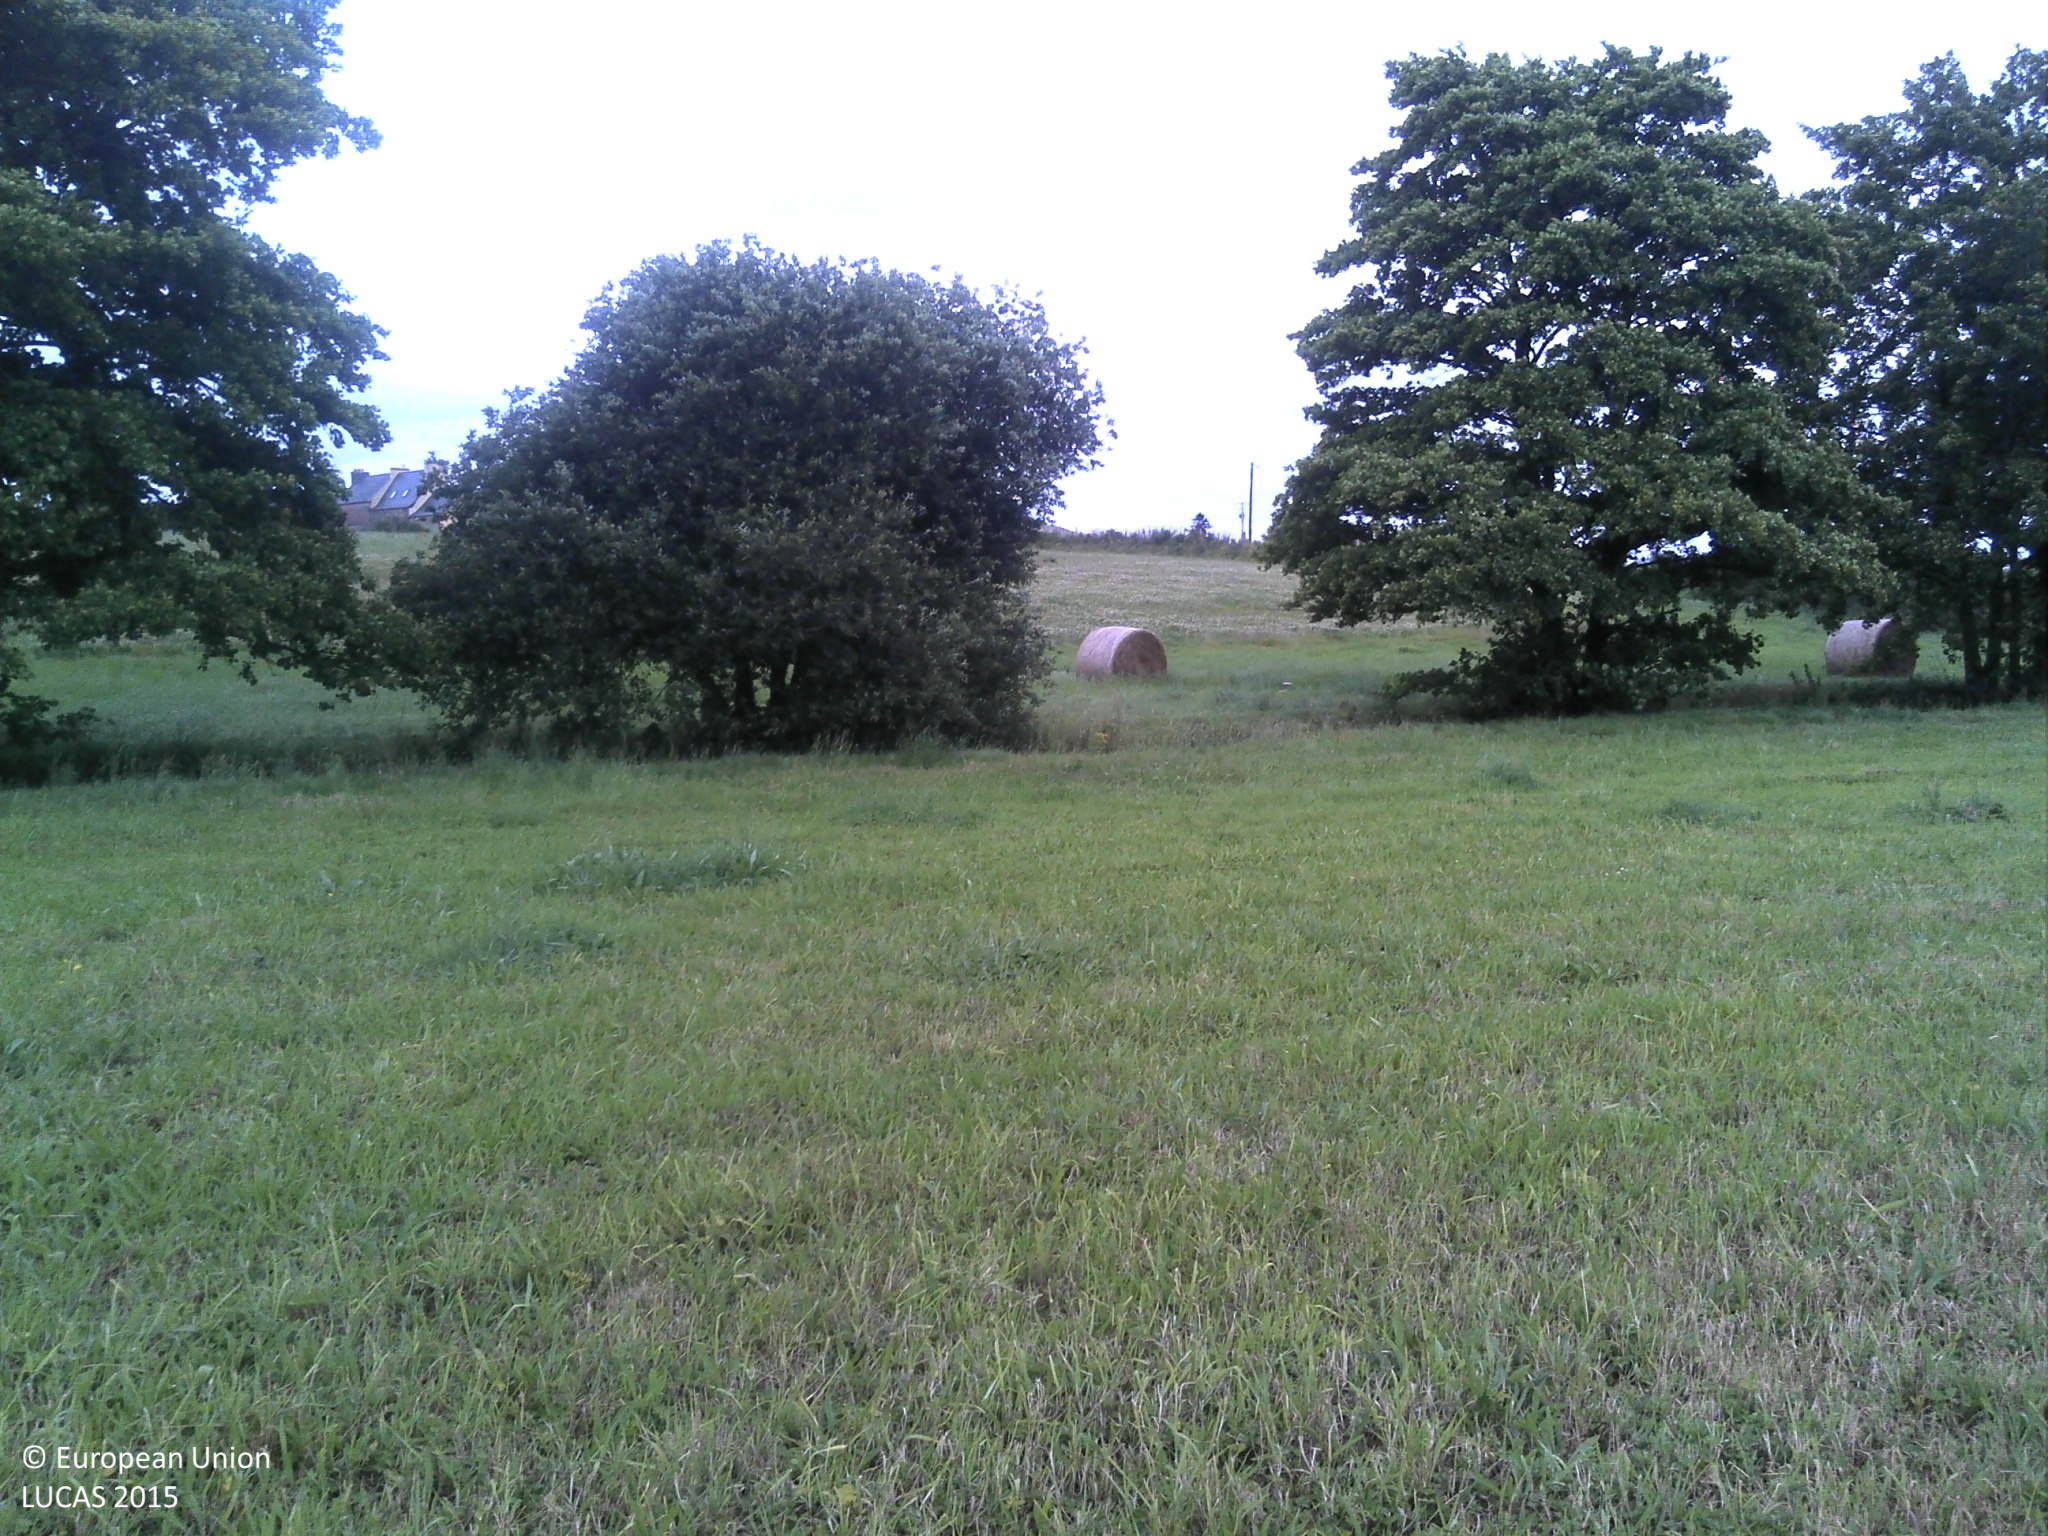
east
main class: Grassland
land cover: Grassland without tree/shrub cover
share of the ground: > 75 %
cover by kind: herbaceous plants 100 %
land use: Agriculture (excluding fallow land and kitchen gardens)
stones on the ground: < 10 %
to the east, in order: Grassland without tree/shrub cover; Rivers and streams; Lines of trees; Fences; Grassland without tree/shrub cover; Clovers; Fences; Electric lines; Grass margins; Paved roads, cycling and walking lanes; Grass margins; Ditches and canals; Fences; Grassland without tree/shrub cover; Fences; Grassland without tree/shrub cover; Fences; Grassland without tree/shrub cover
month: July
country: FR
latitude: 48.5816
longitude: -3.7341
